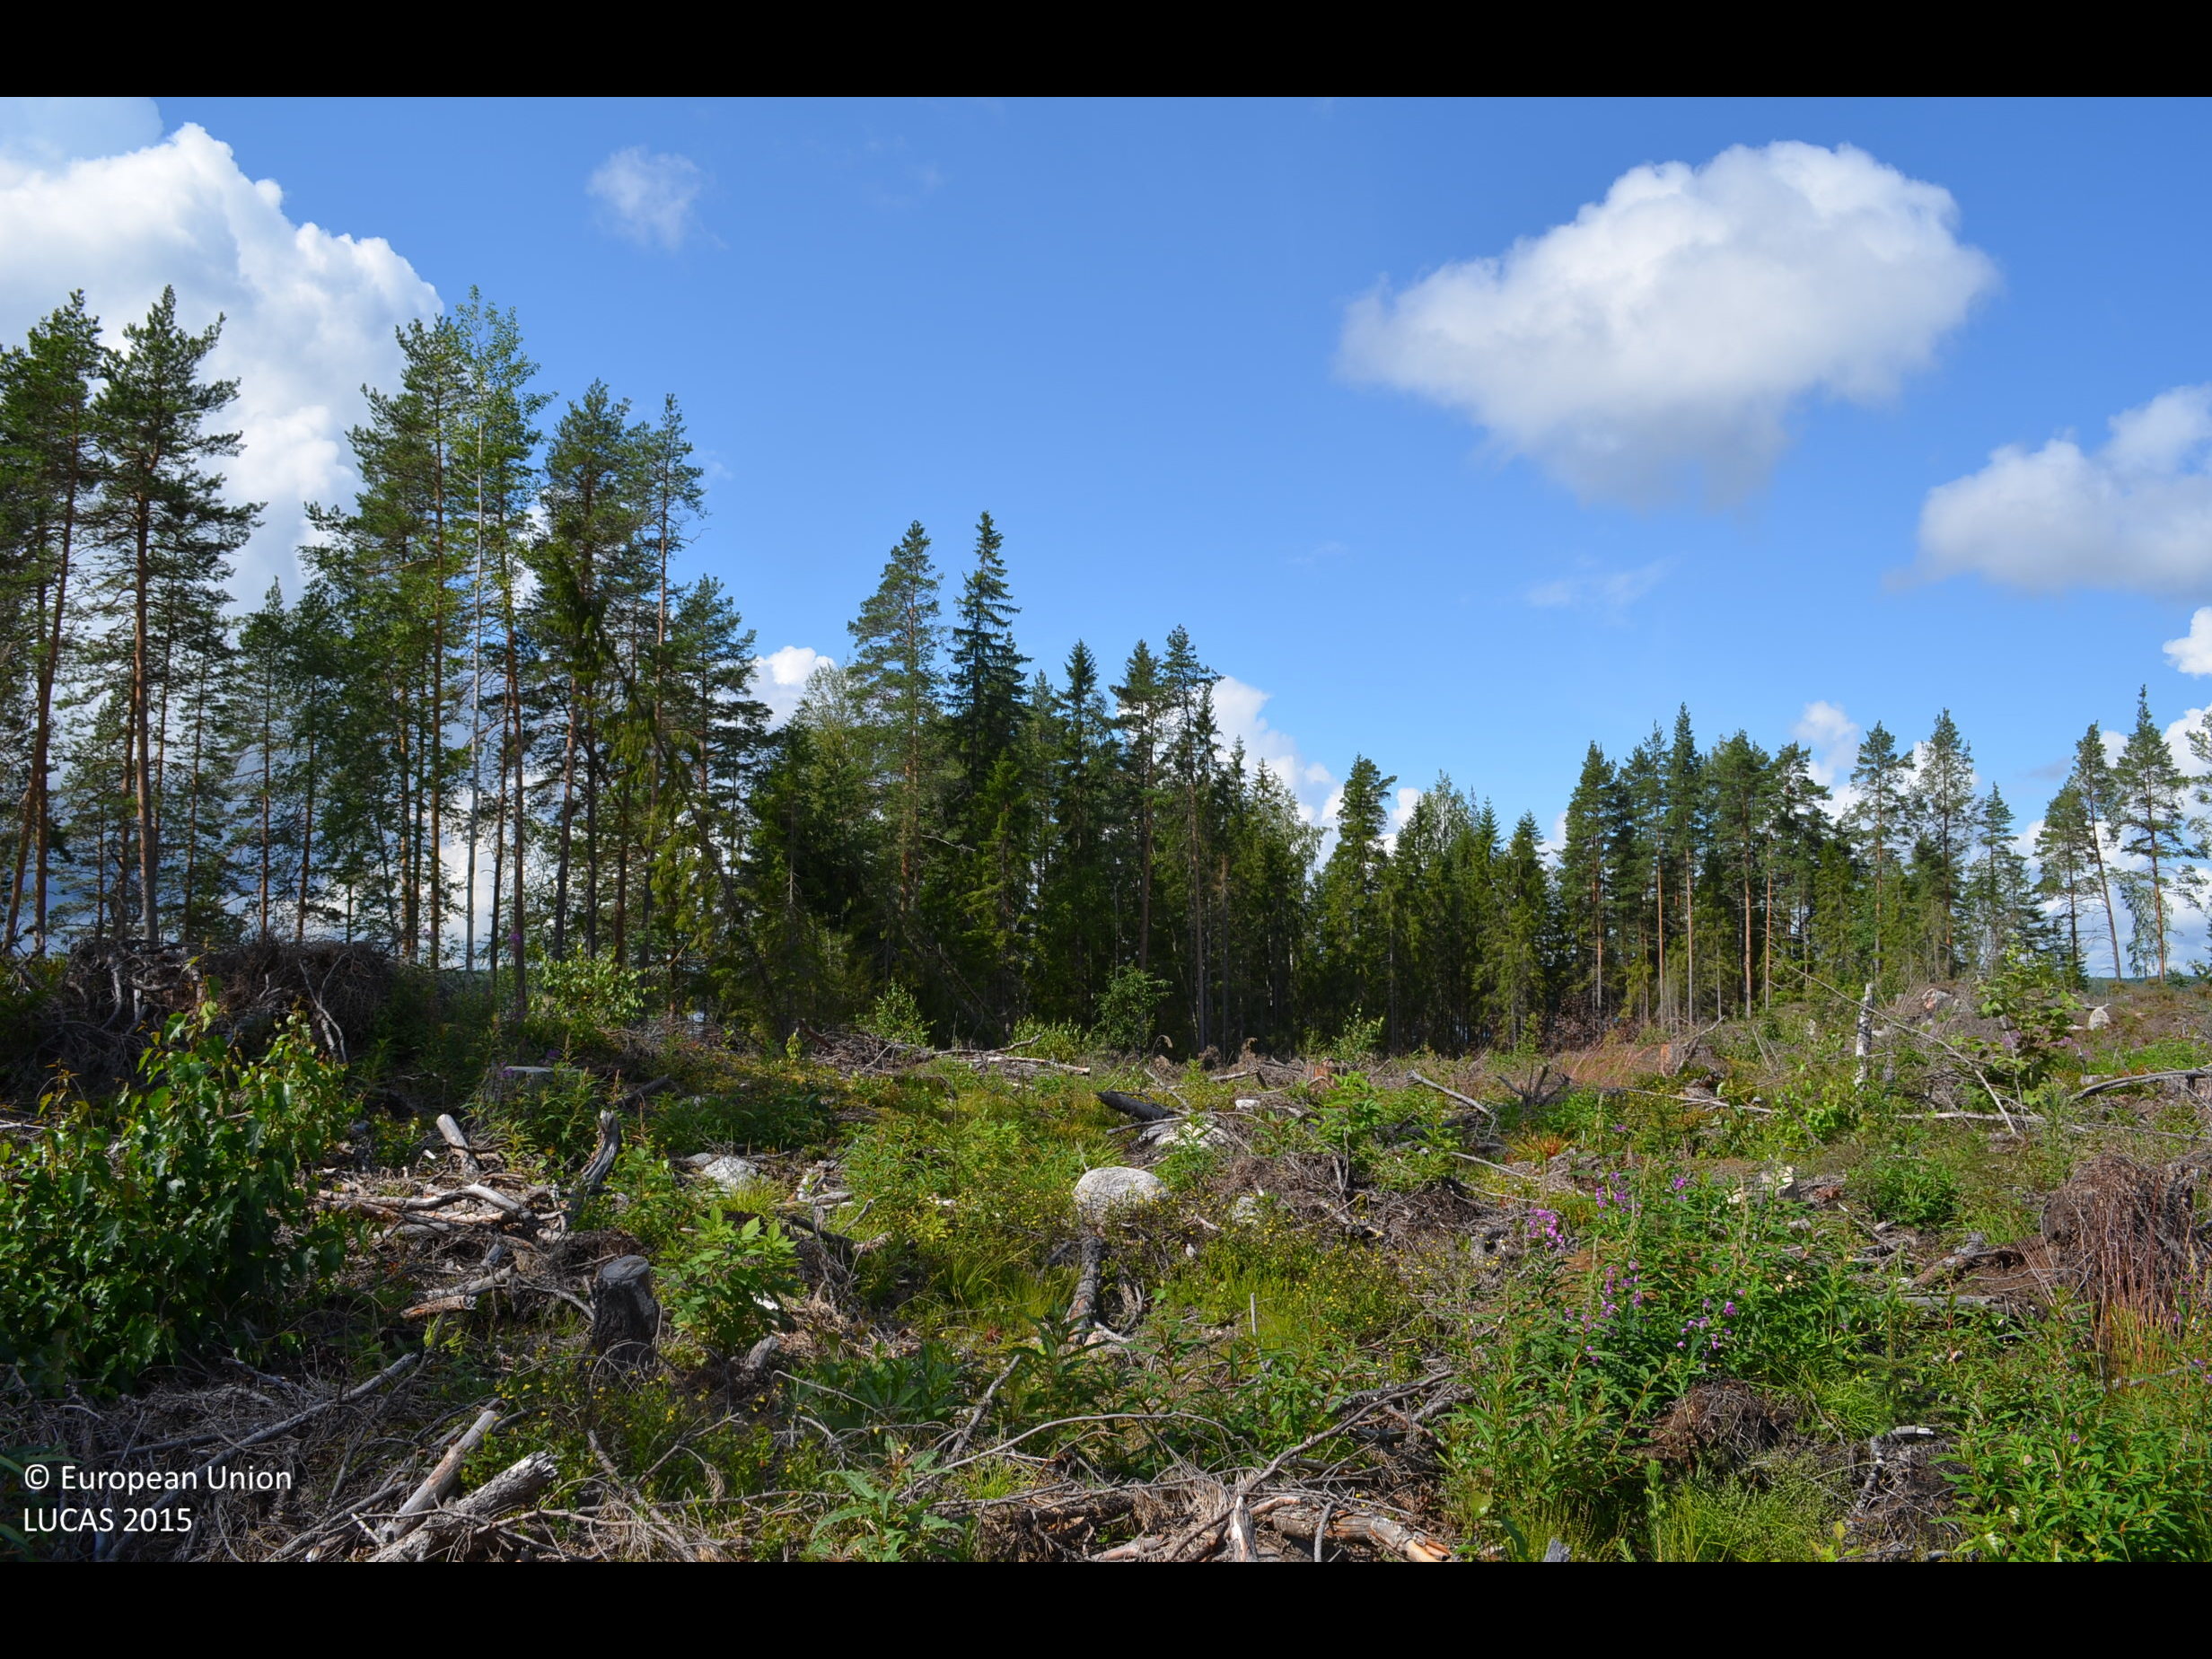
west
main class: Shrubland
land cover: Shrubland with sparse tree cover
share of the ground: 25 - 50 %
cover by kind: shrubs 40 %, herbaceous plants 15 %, consolidated bare surface 15 %, broadleaved forest trees 5 %
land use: Forestry
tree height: < 5 m
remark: Clear cut
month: July
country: FI
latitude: 61.9975
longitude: 24.1195
